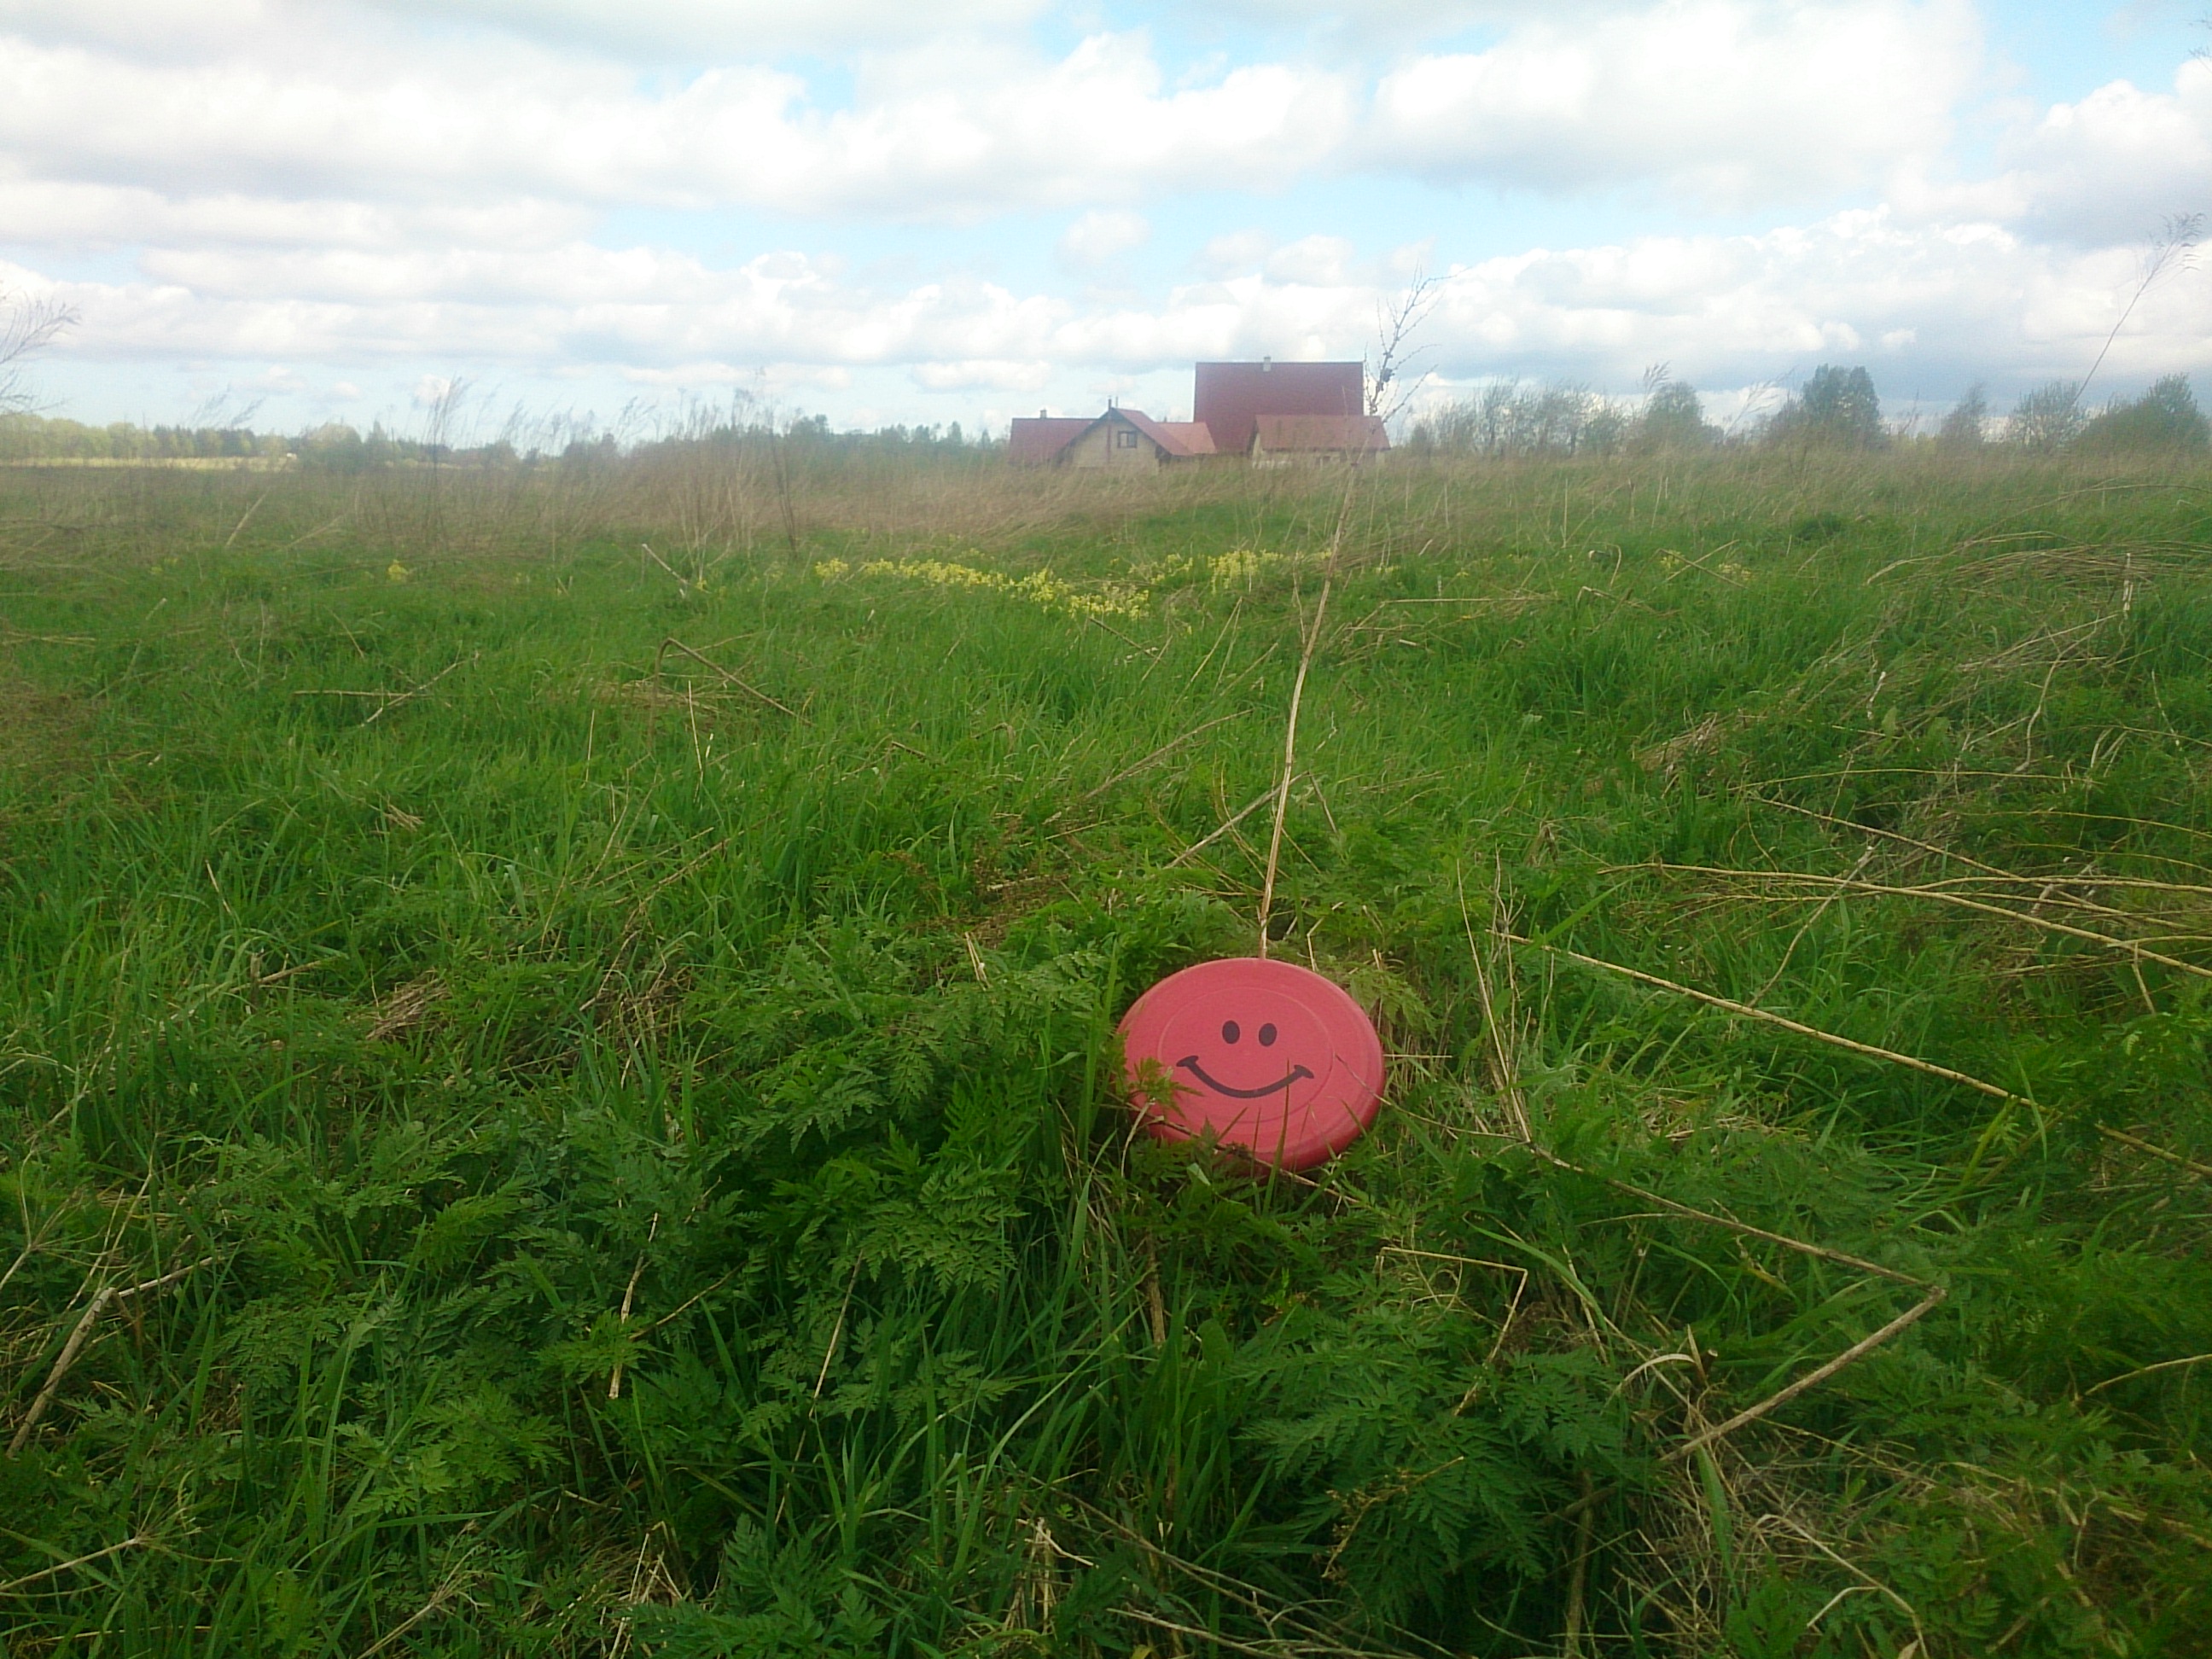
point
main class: Grassland
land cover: Spontaneously vegetated surfaces
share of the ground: > 75 %
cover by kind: herbaceous plants 100 %
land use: Abandoned areas
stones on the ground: < 10 %
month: May
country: LV
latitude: 56.7954
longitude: 24.2517
